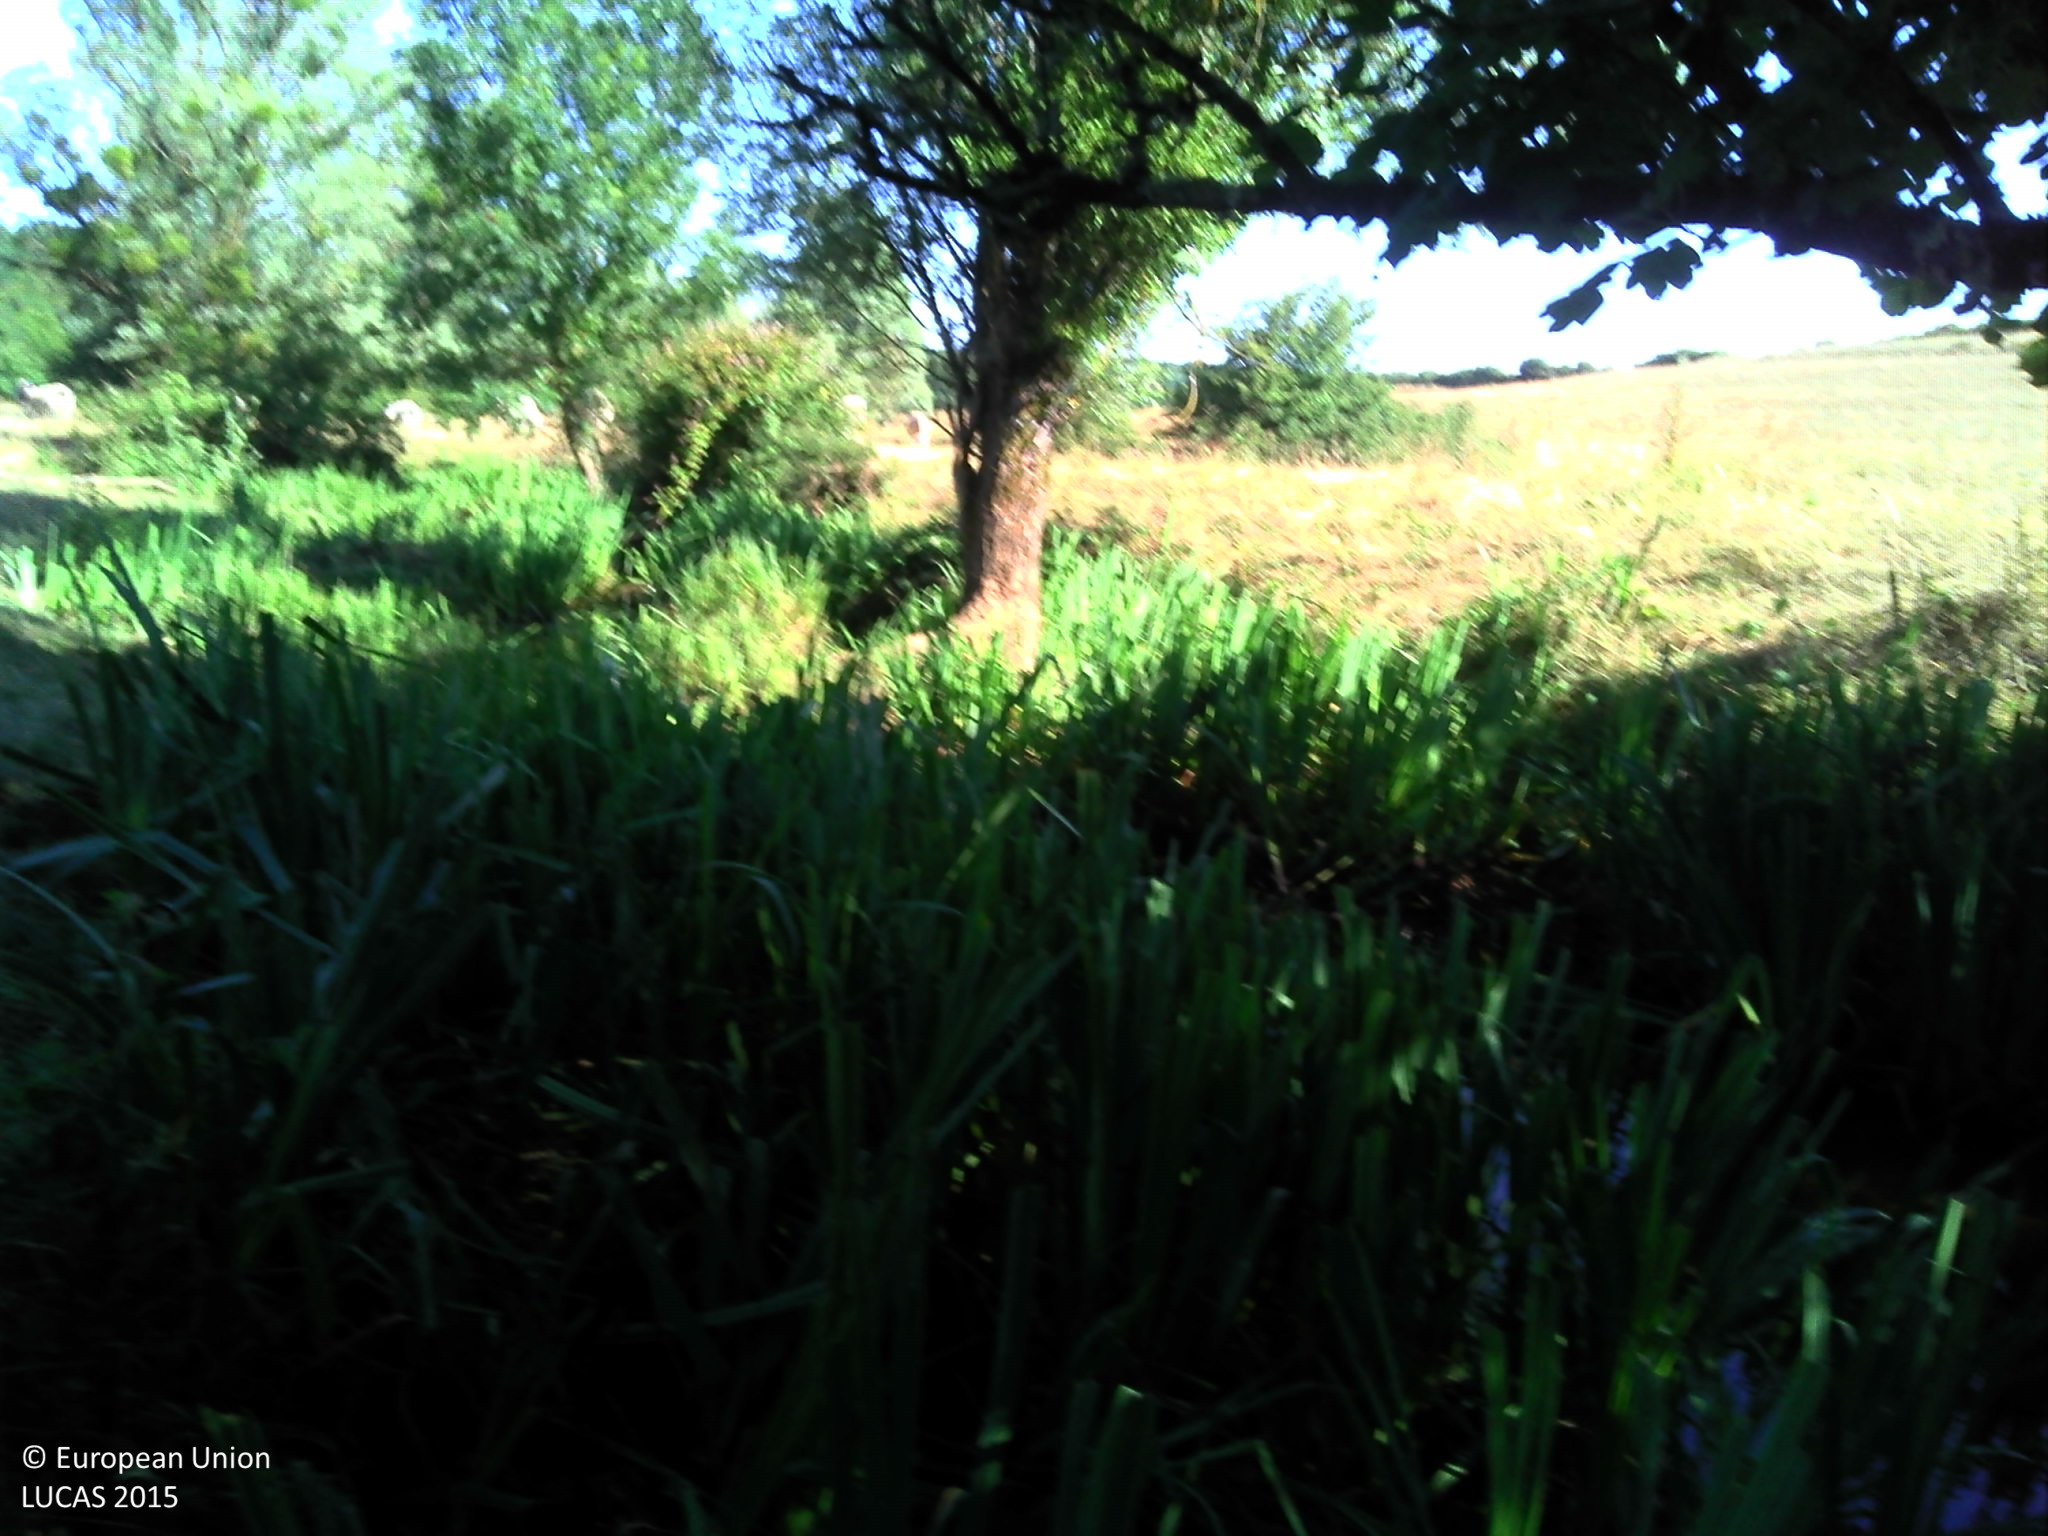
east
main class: Grassland
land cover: Grassland without tree/shrub cover
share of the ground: > 75 %
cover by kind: herbaceous plants 100 %
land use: Agriculture (excluding fallow land and kitchen gardens)
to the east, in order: Grassland without tree/shrub cover; Fences; Broadleaved woodland; Tracks; Broadleaved woodland
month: July
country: FR
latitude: 46.9900
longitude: 3.5944
